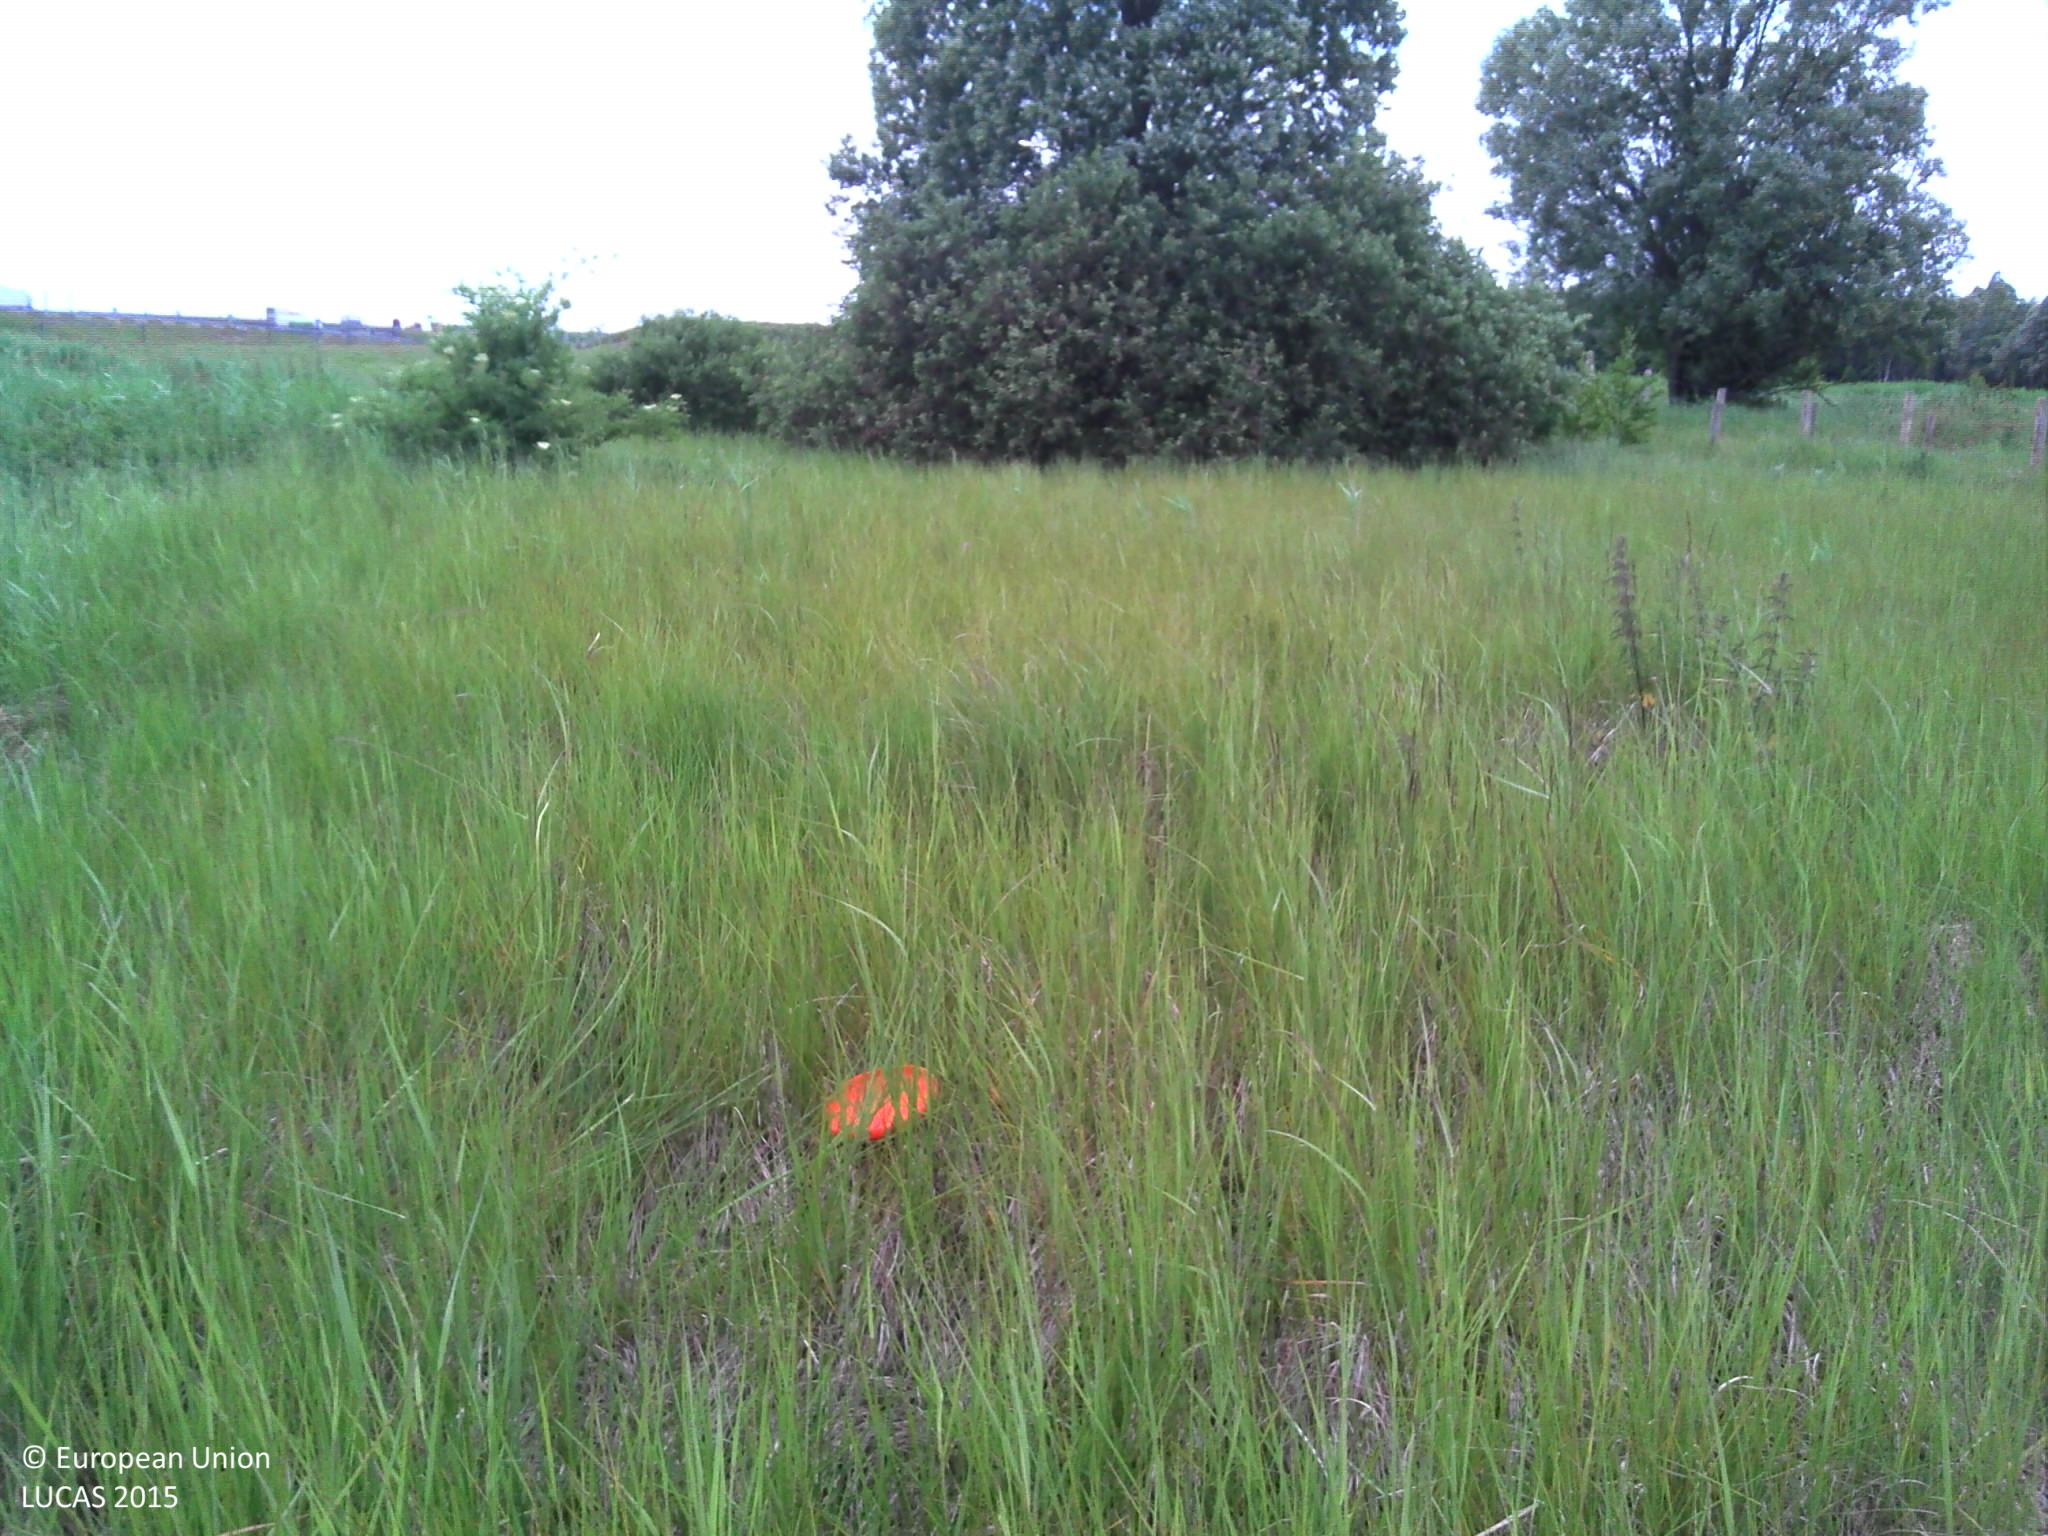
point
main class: Grassland
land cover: Grassland without tree/shrub cover
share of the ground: > 75 %
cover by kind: herbaceous plants 100 %
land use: Semi-natural and natural areas not in use
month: June
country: BE
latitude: 51.2469
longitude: 4.2502
